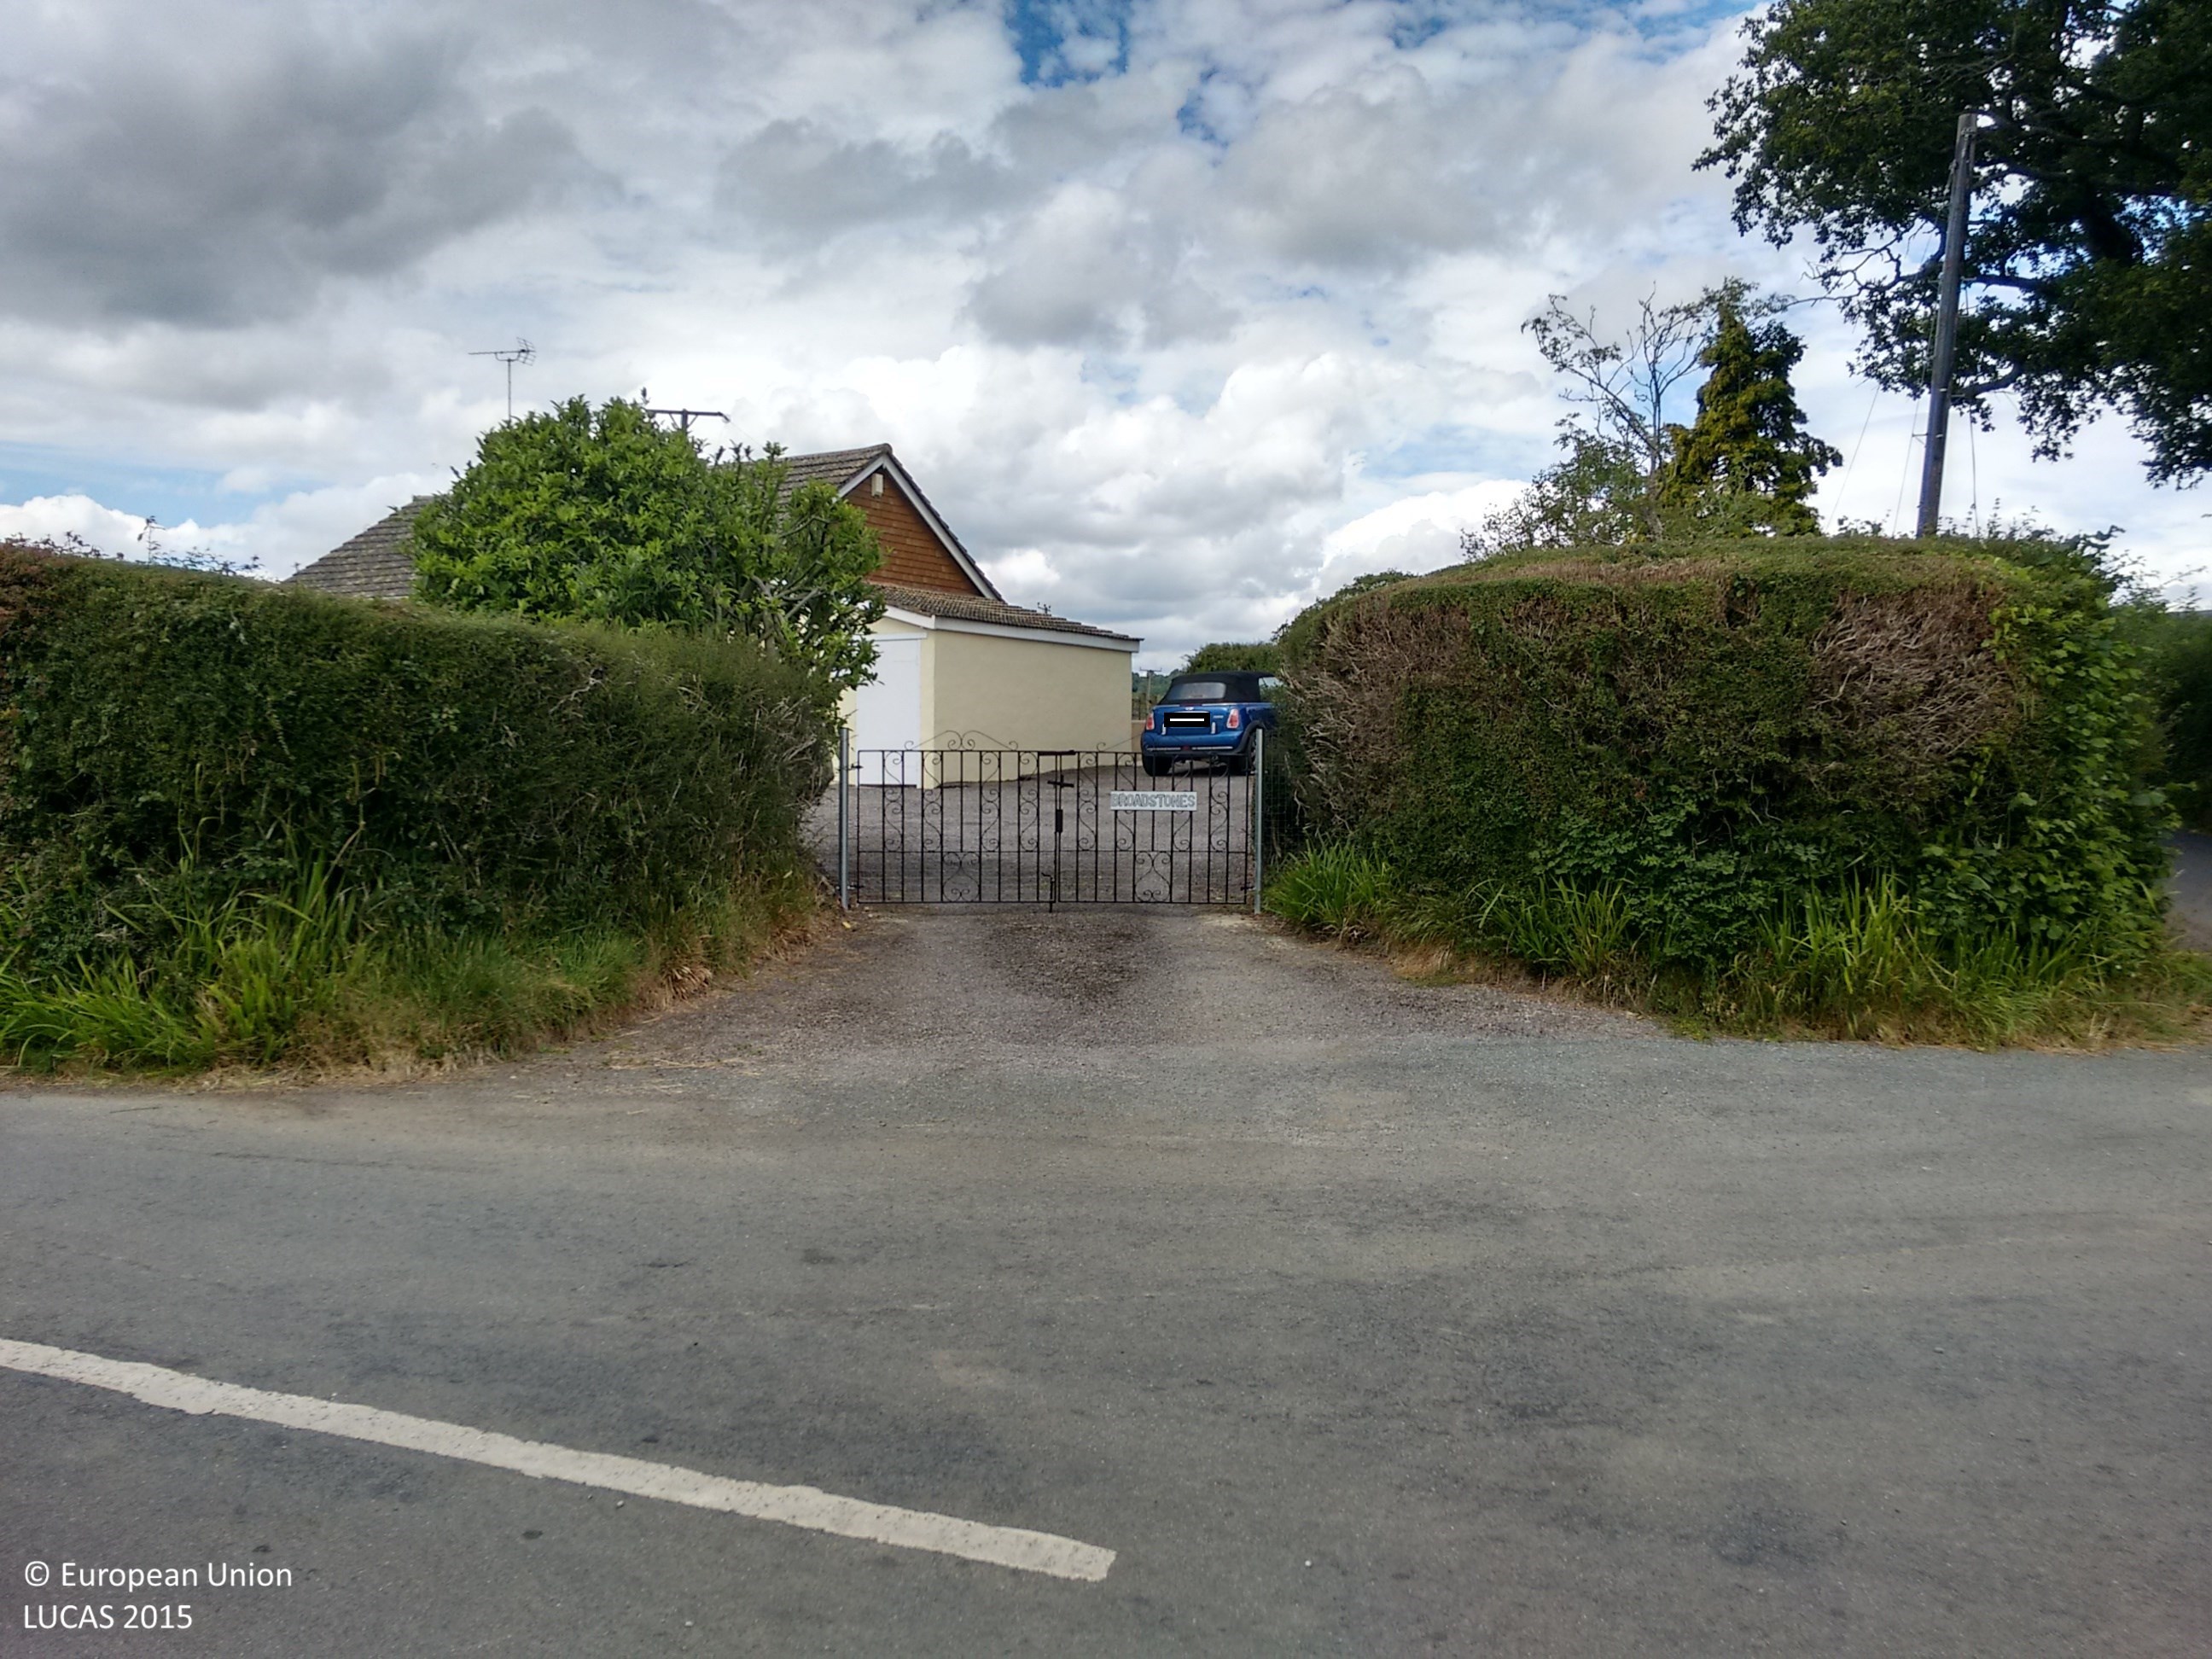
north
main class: Cropland
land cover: Maize
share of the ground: > 75 %
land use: Agriculture (excluding fallow land and kitchen gardens)
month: July
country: GB
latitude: 50.7828
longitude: -2.8513
